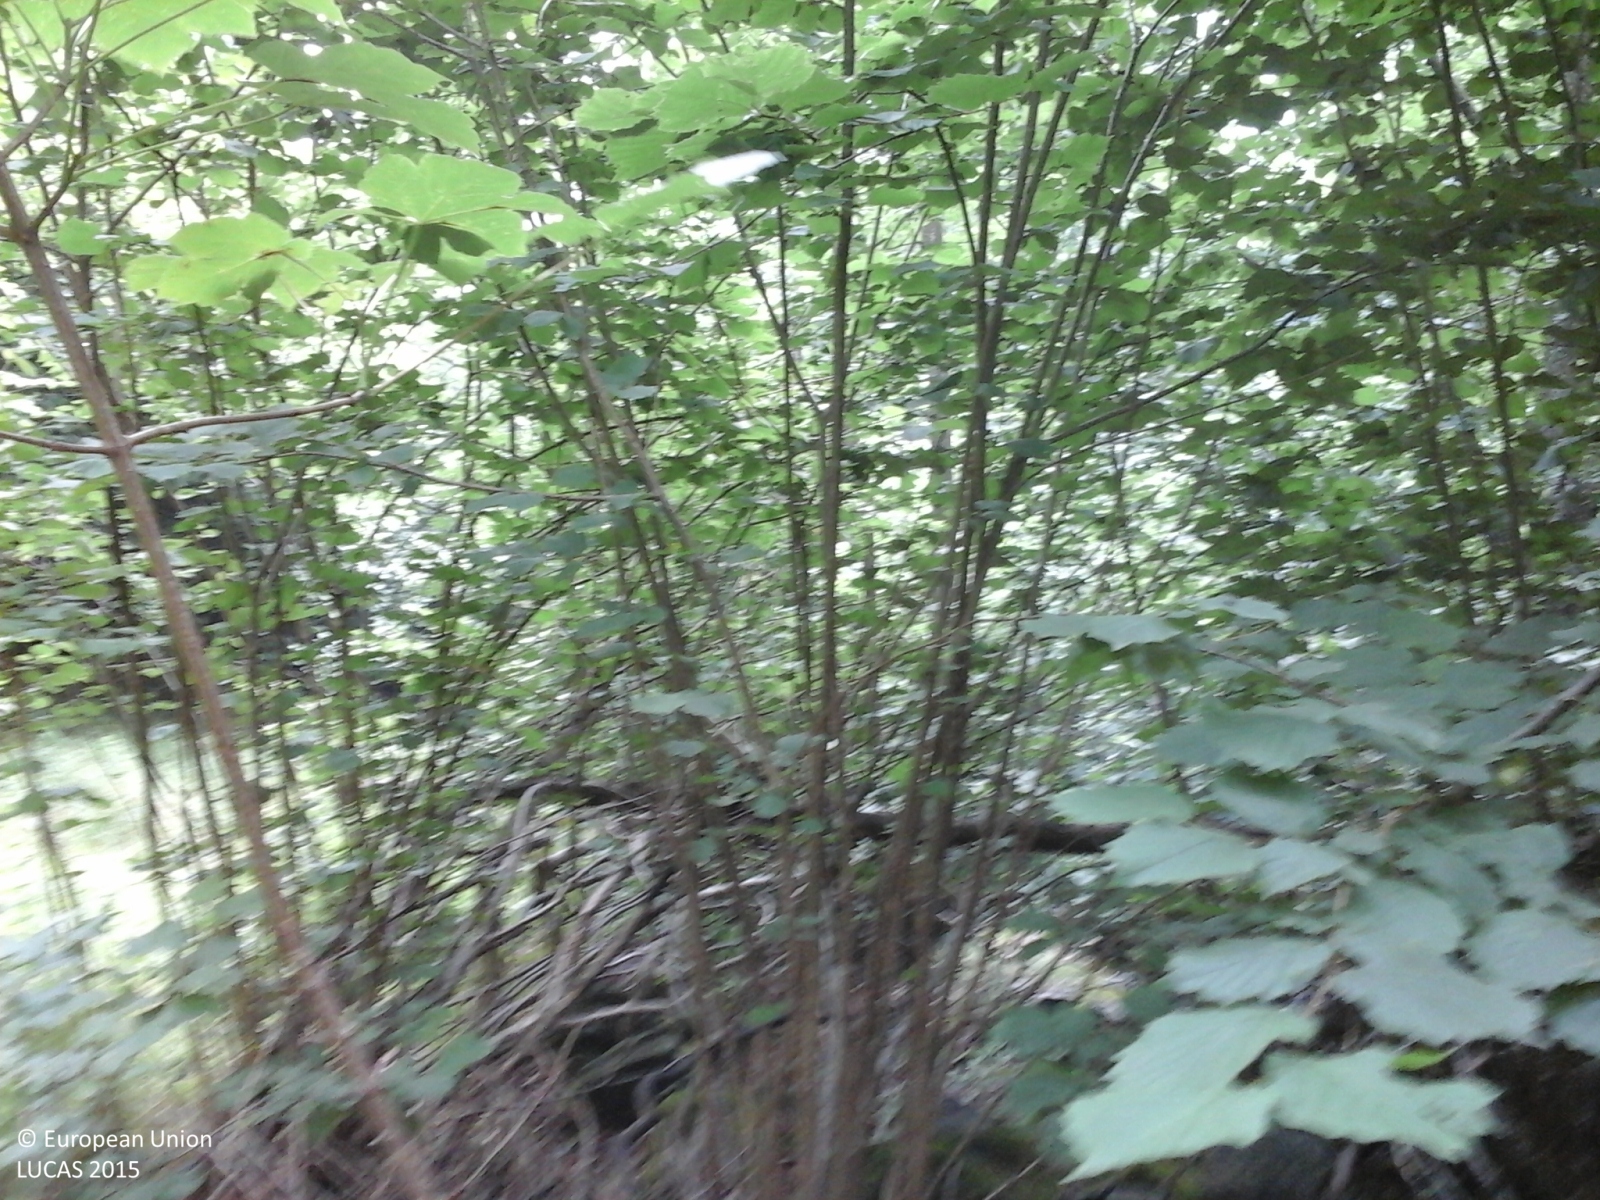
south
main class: Woodland
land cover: Broadleaved woodland
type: beech forest
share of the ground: > 75 %
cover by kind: broadleaved forest trees 100 %
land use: Forestry
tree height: > 5 m
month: July
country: IT
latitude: 45.2339
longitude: 7.2403
